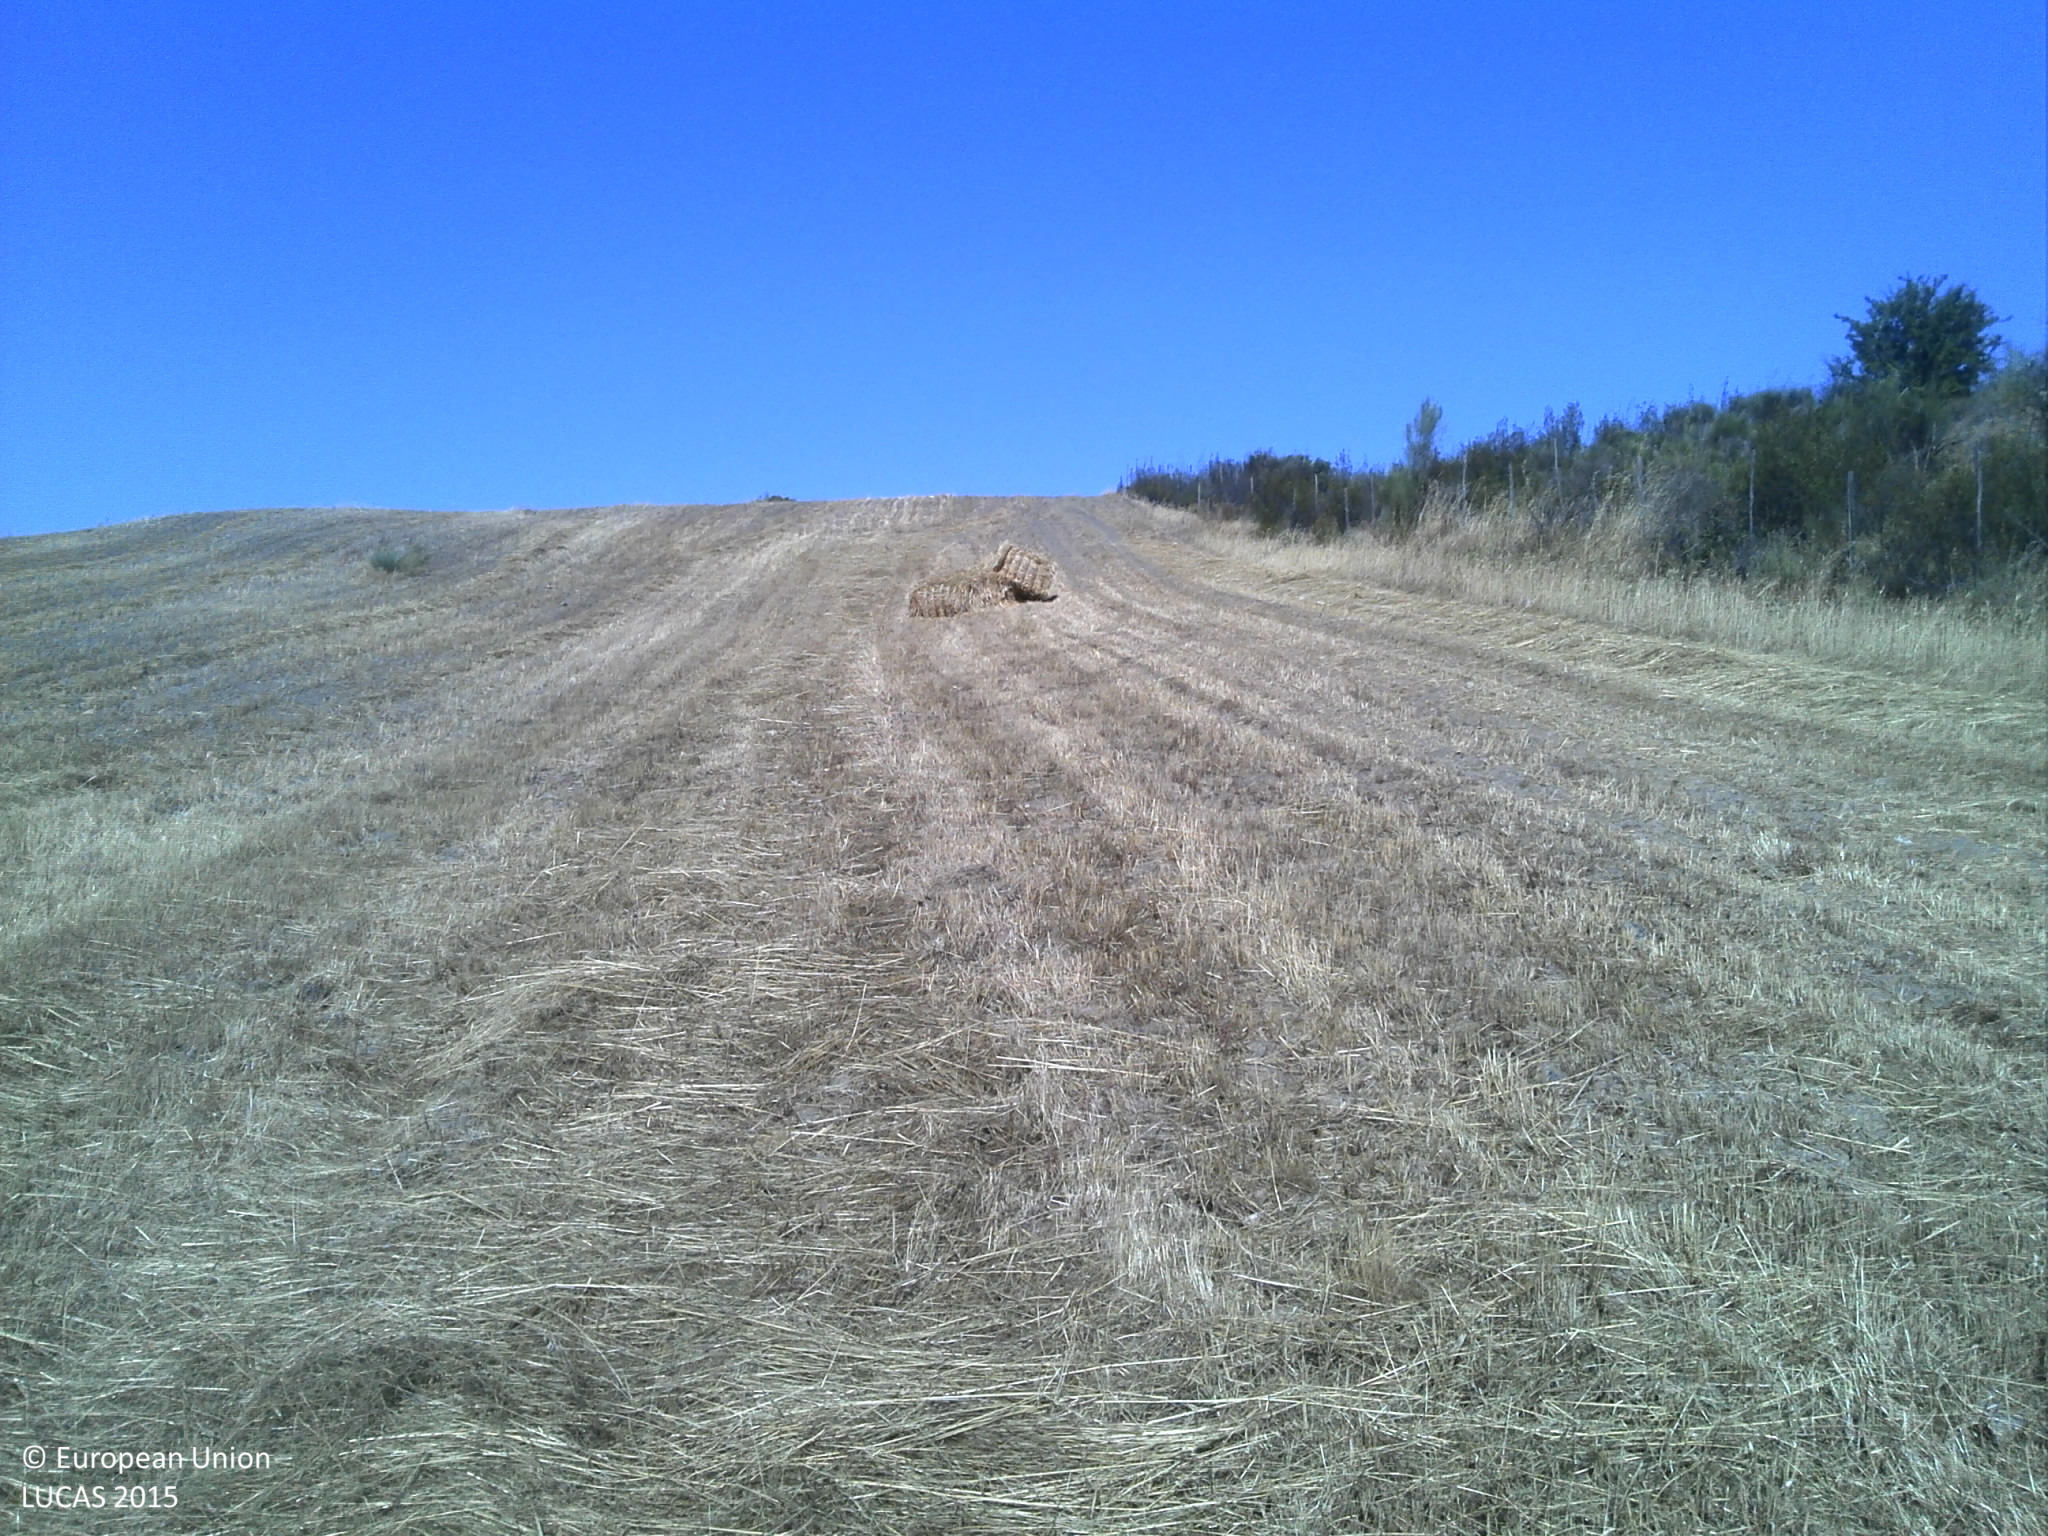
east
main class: Cropland
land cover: Temporary grasslands
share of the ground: 25 - 50 %
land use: Agriculture (excluding fallow land and kitchen gardens)
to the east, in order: Temporary grasslands; Tracks; Shrubland without tree cover; Tracks; Fences; Shrubland with sparse tree cover; Abandoned hedges; Inland fresh running water
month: June
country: PT
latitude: 39.9970
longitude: -7.1596
